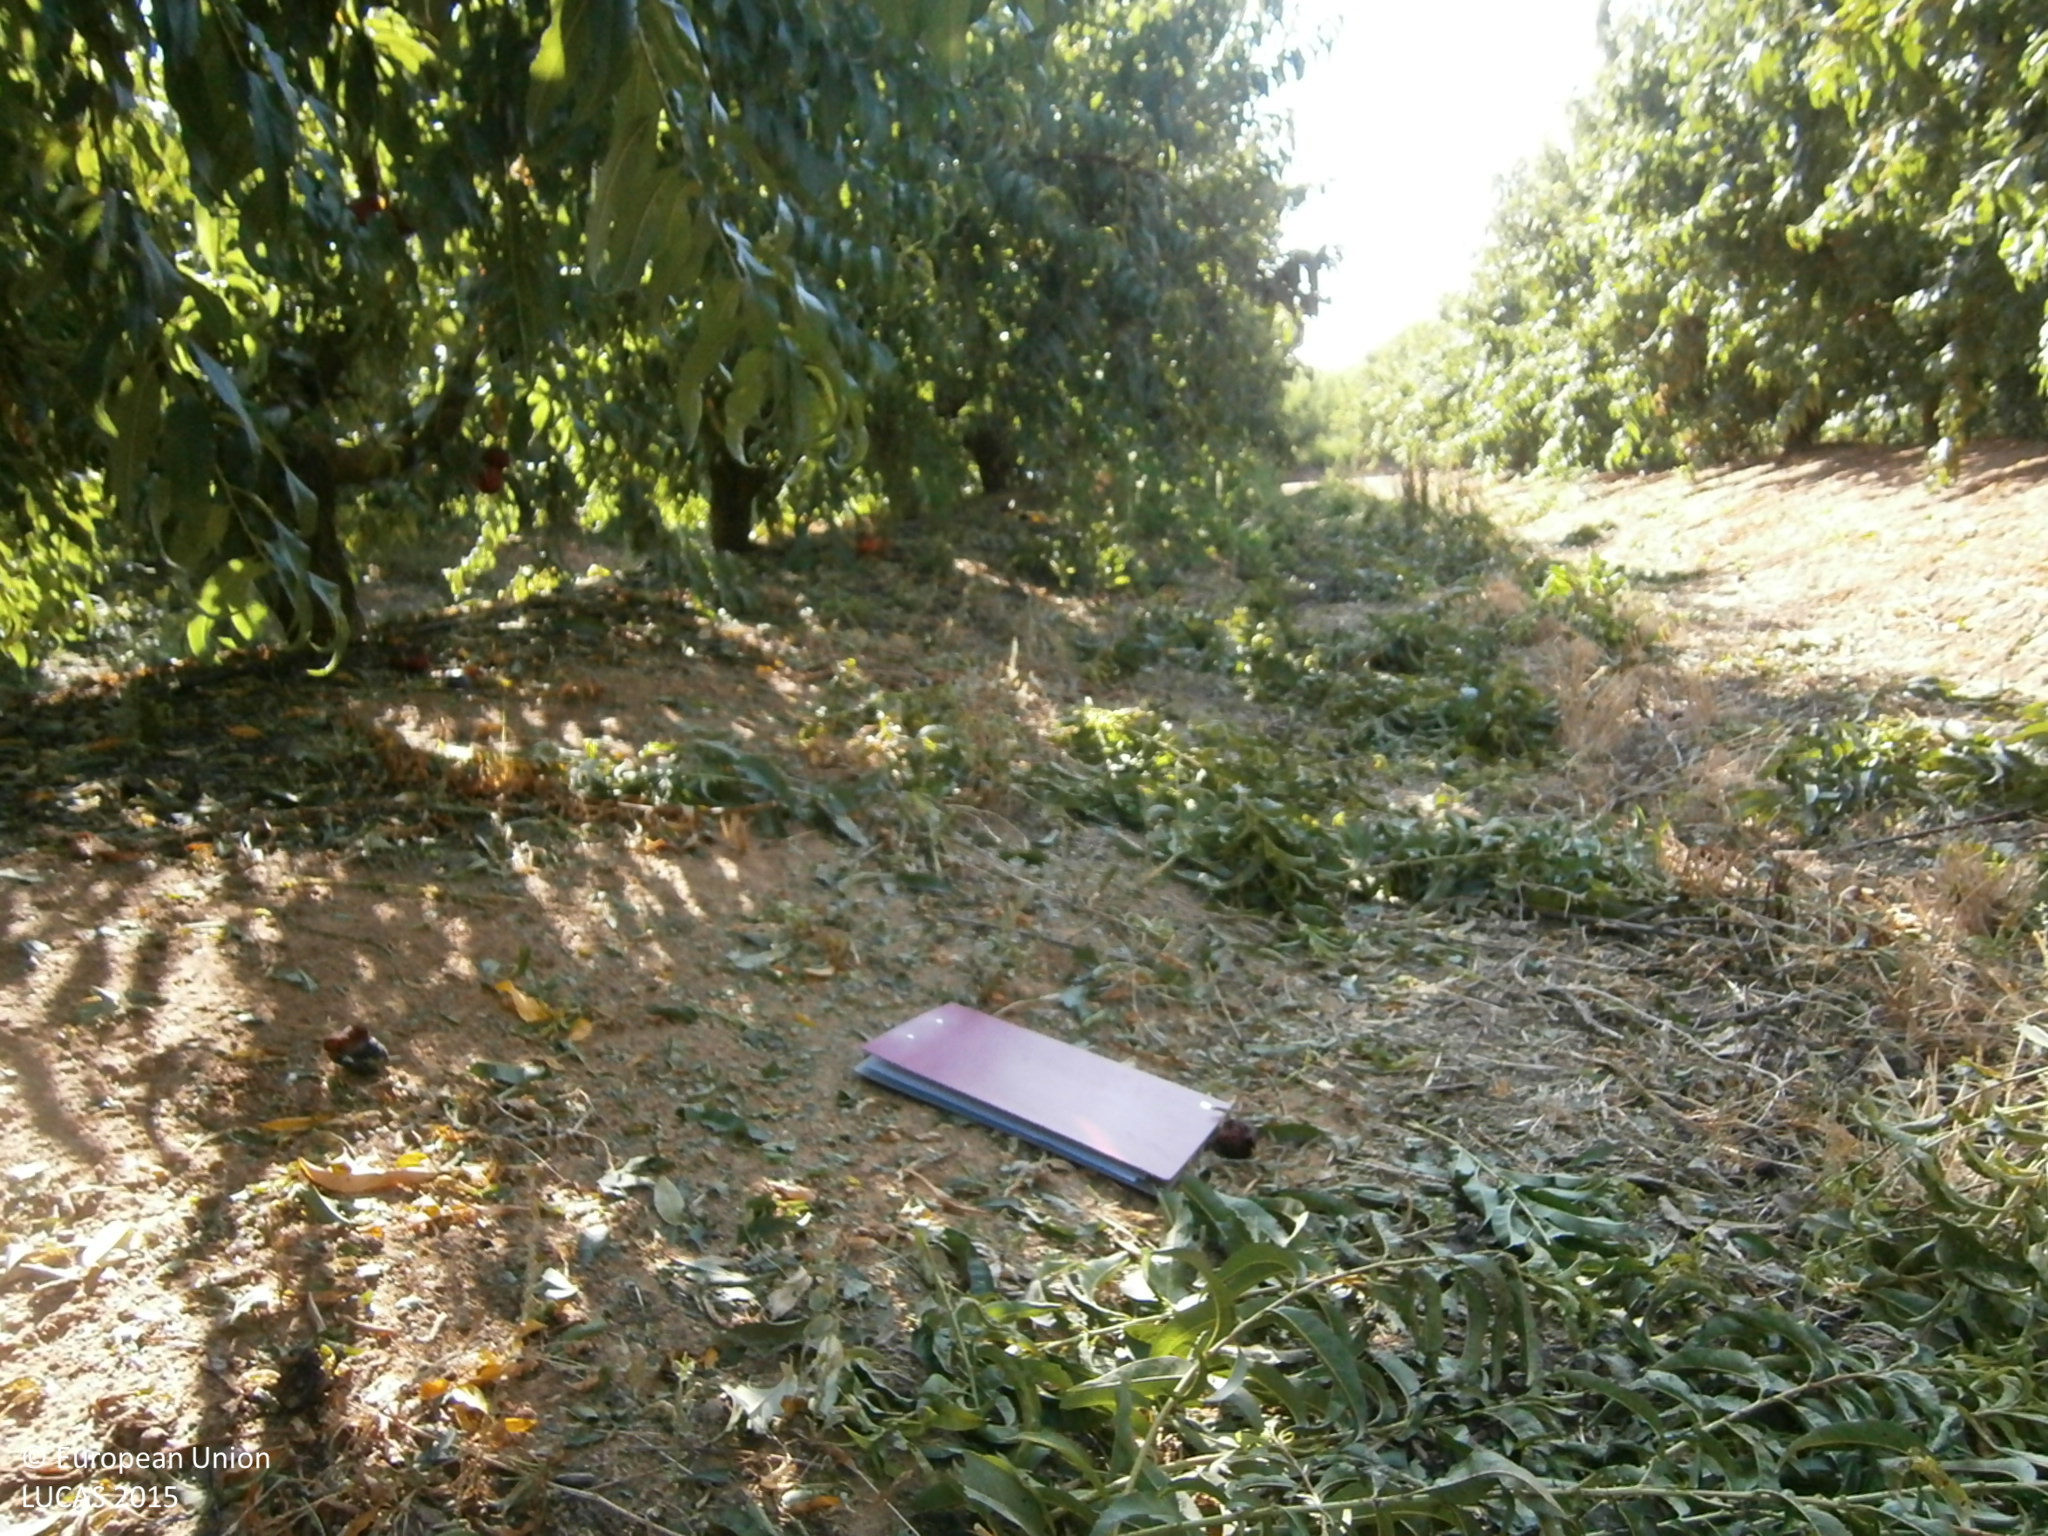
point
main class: Cropland
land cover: Other fruit trees and berries
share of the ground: 25 - 50 %
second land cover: Spontaneously vegetated surfaces
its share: 25 - 50 %
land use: Agriculture (excluding fallow land and kitchen gardens)
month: July
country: ES
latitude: 38.9326
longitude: -6.9235
